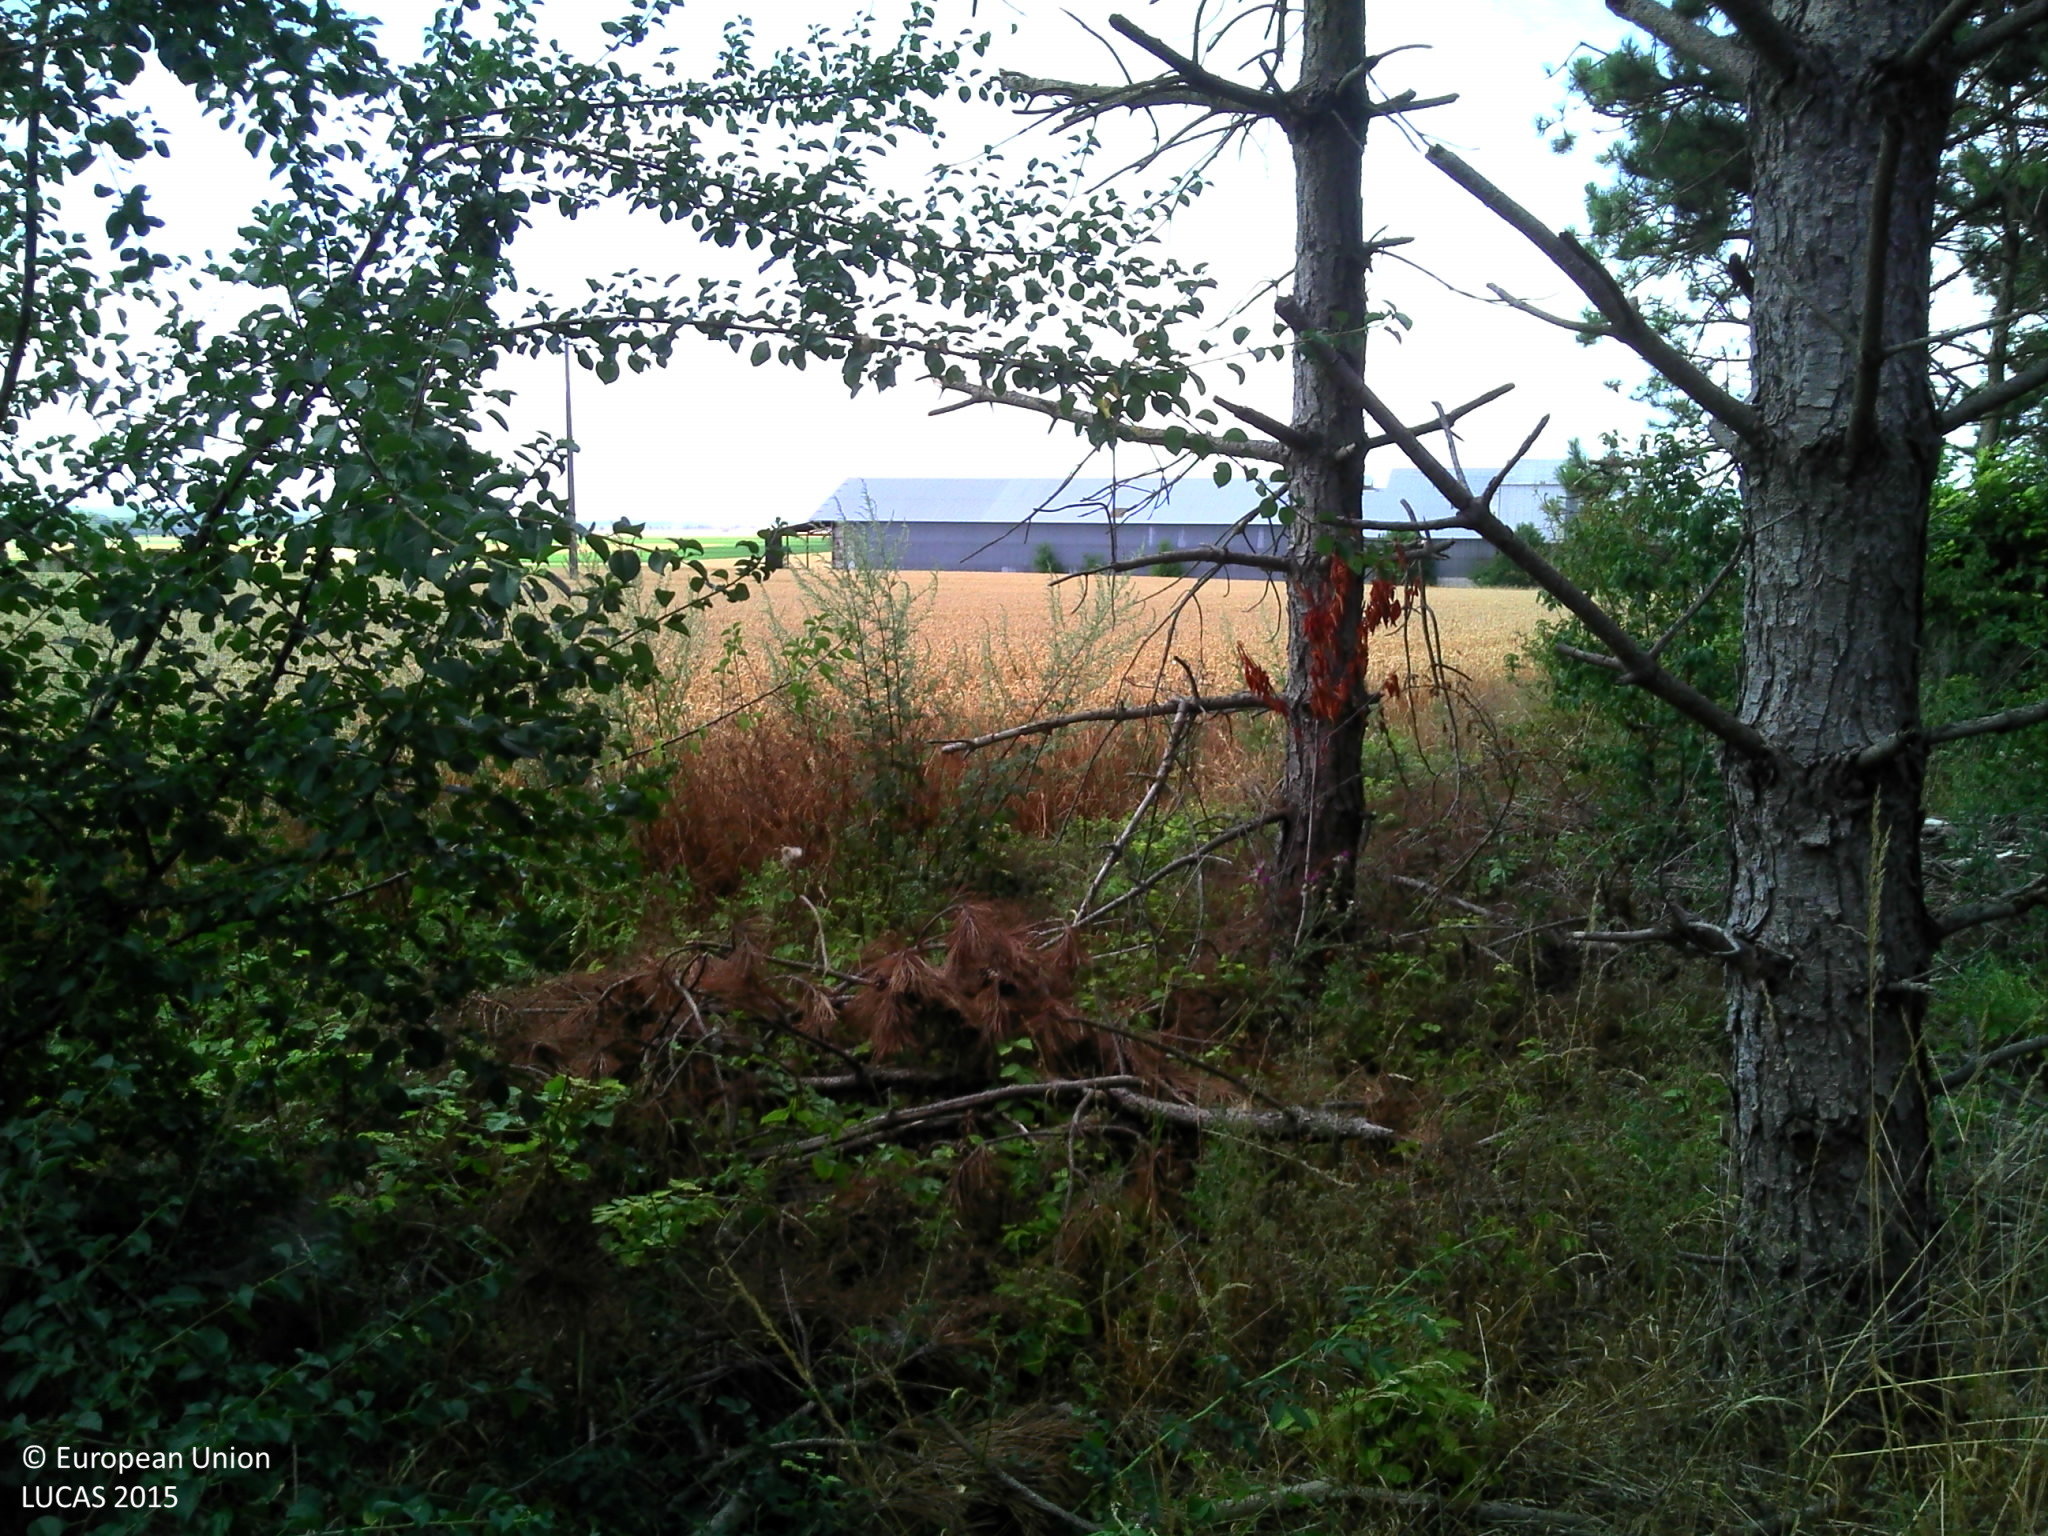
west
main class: Woodland
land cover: Pine dominated coniferous woodland
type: boreal forest
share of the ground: > 75 %
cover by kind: coniferous forest trees 60 %, herbaceous plants 30 %, lichens and mosses 5 %, unconsolidated bare surface 5 %
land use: Forestry
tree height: > 5 m
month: July
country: FR
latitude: 49.3859
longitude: 4.1681
